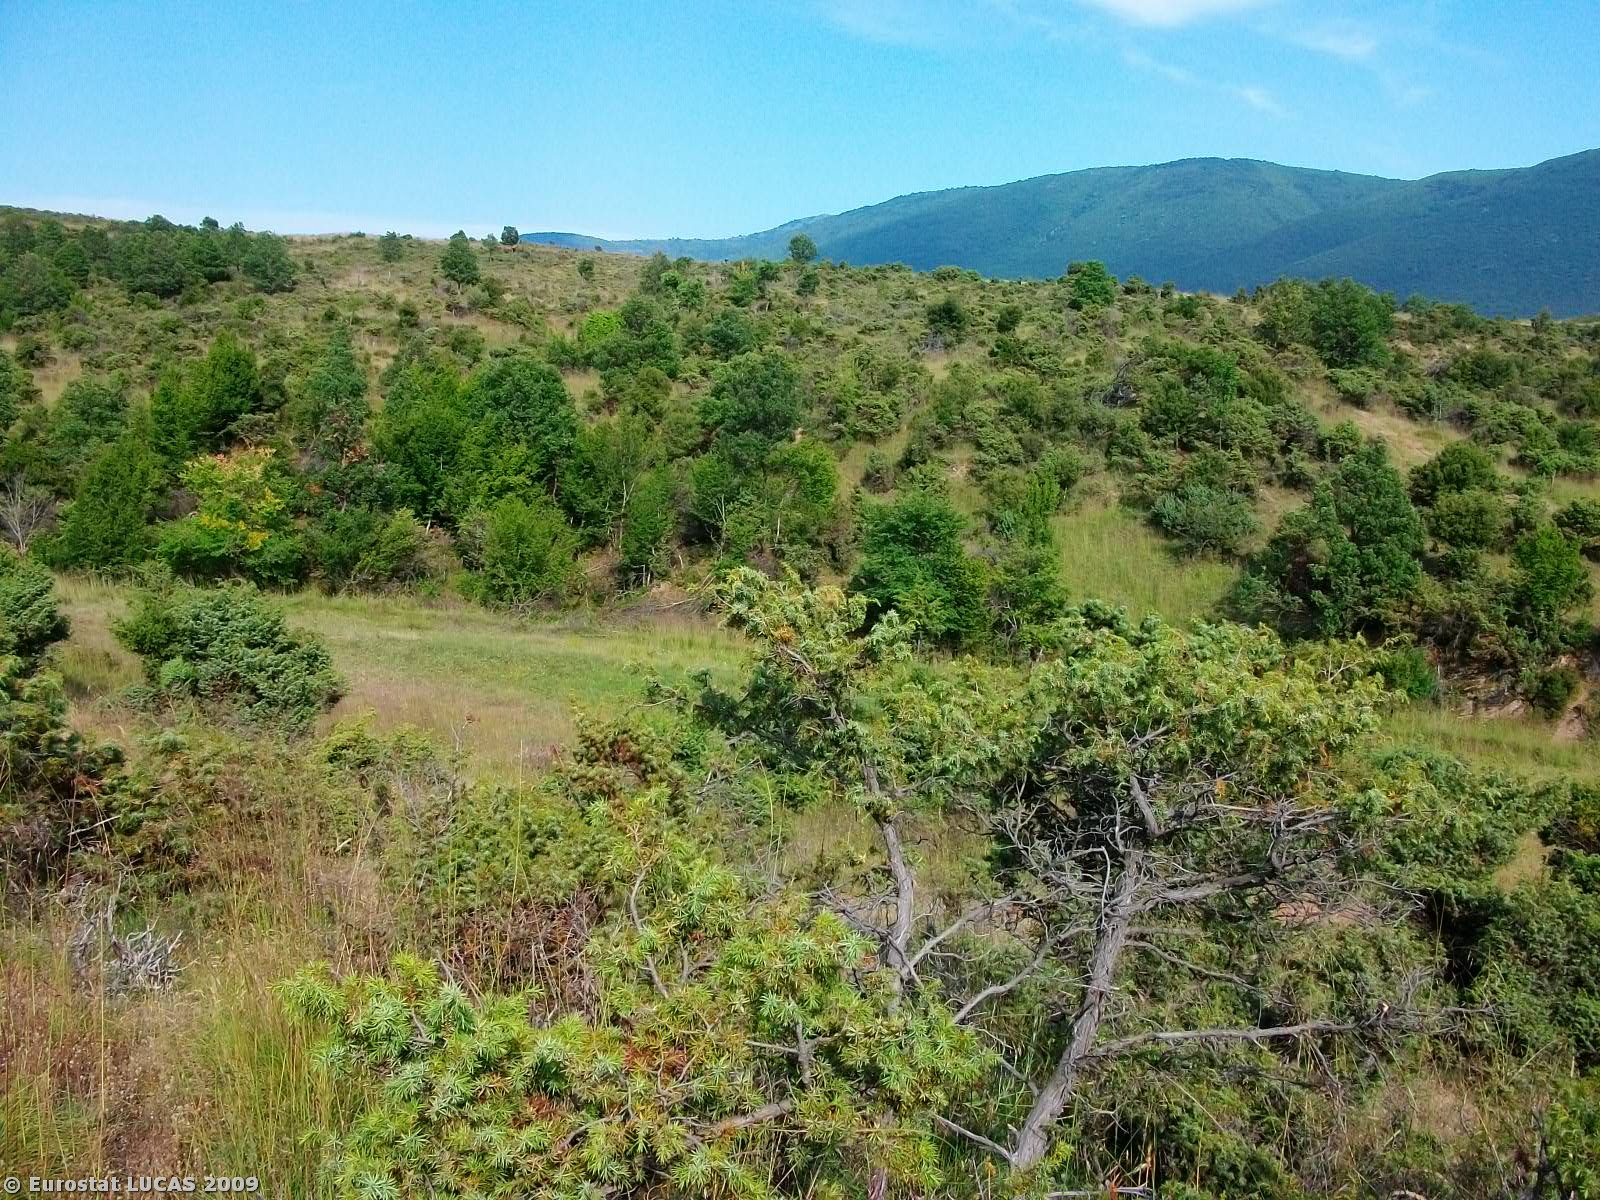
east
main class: Shrubland
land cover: Shrubland without tree cover
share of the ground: > 75 %
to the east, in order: Shrubland without tree cover; Shrubland with sparse tree cover
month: June
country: GR
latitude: 41.2149
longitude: 24.4067
